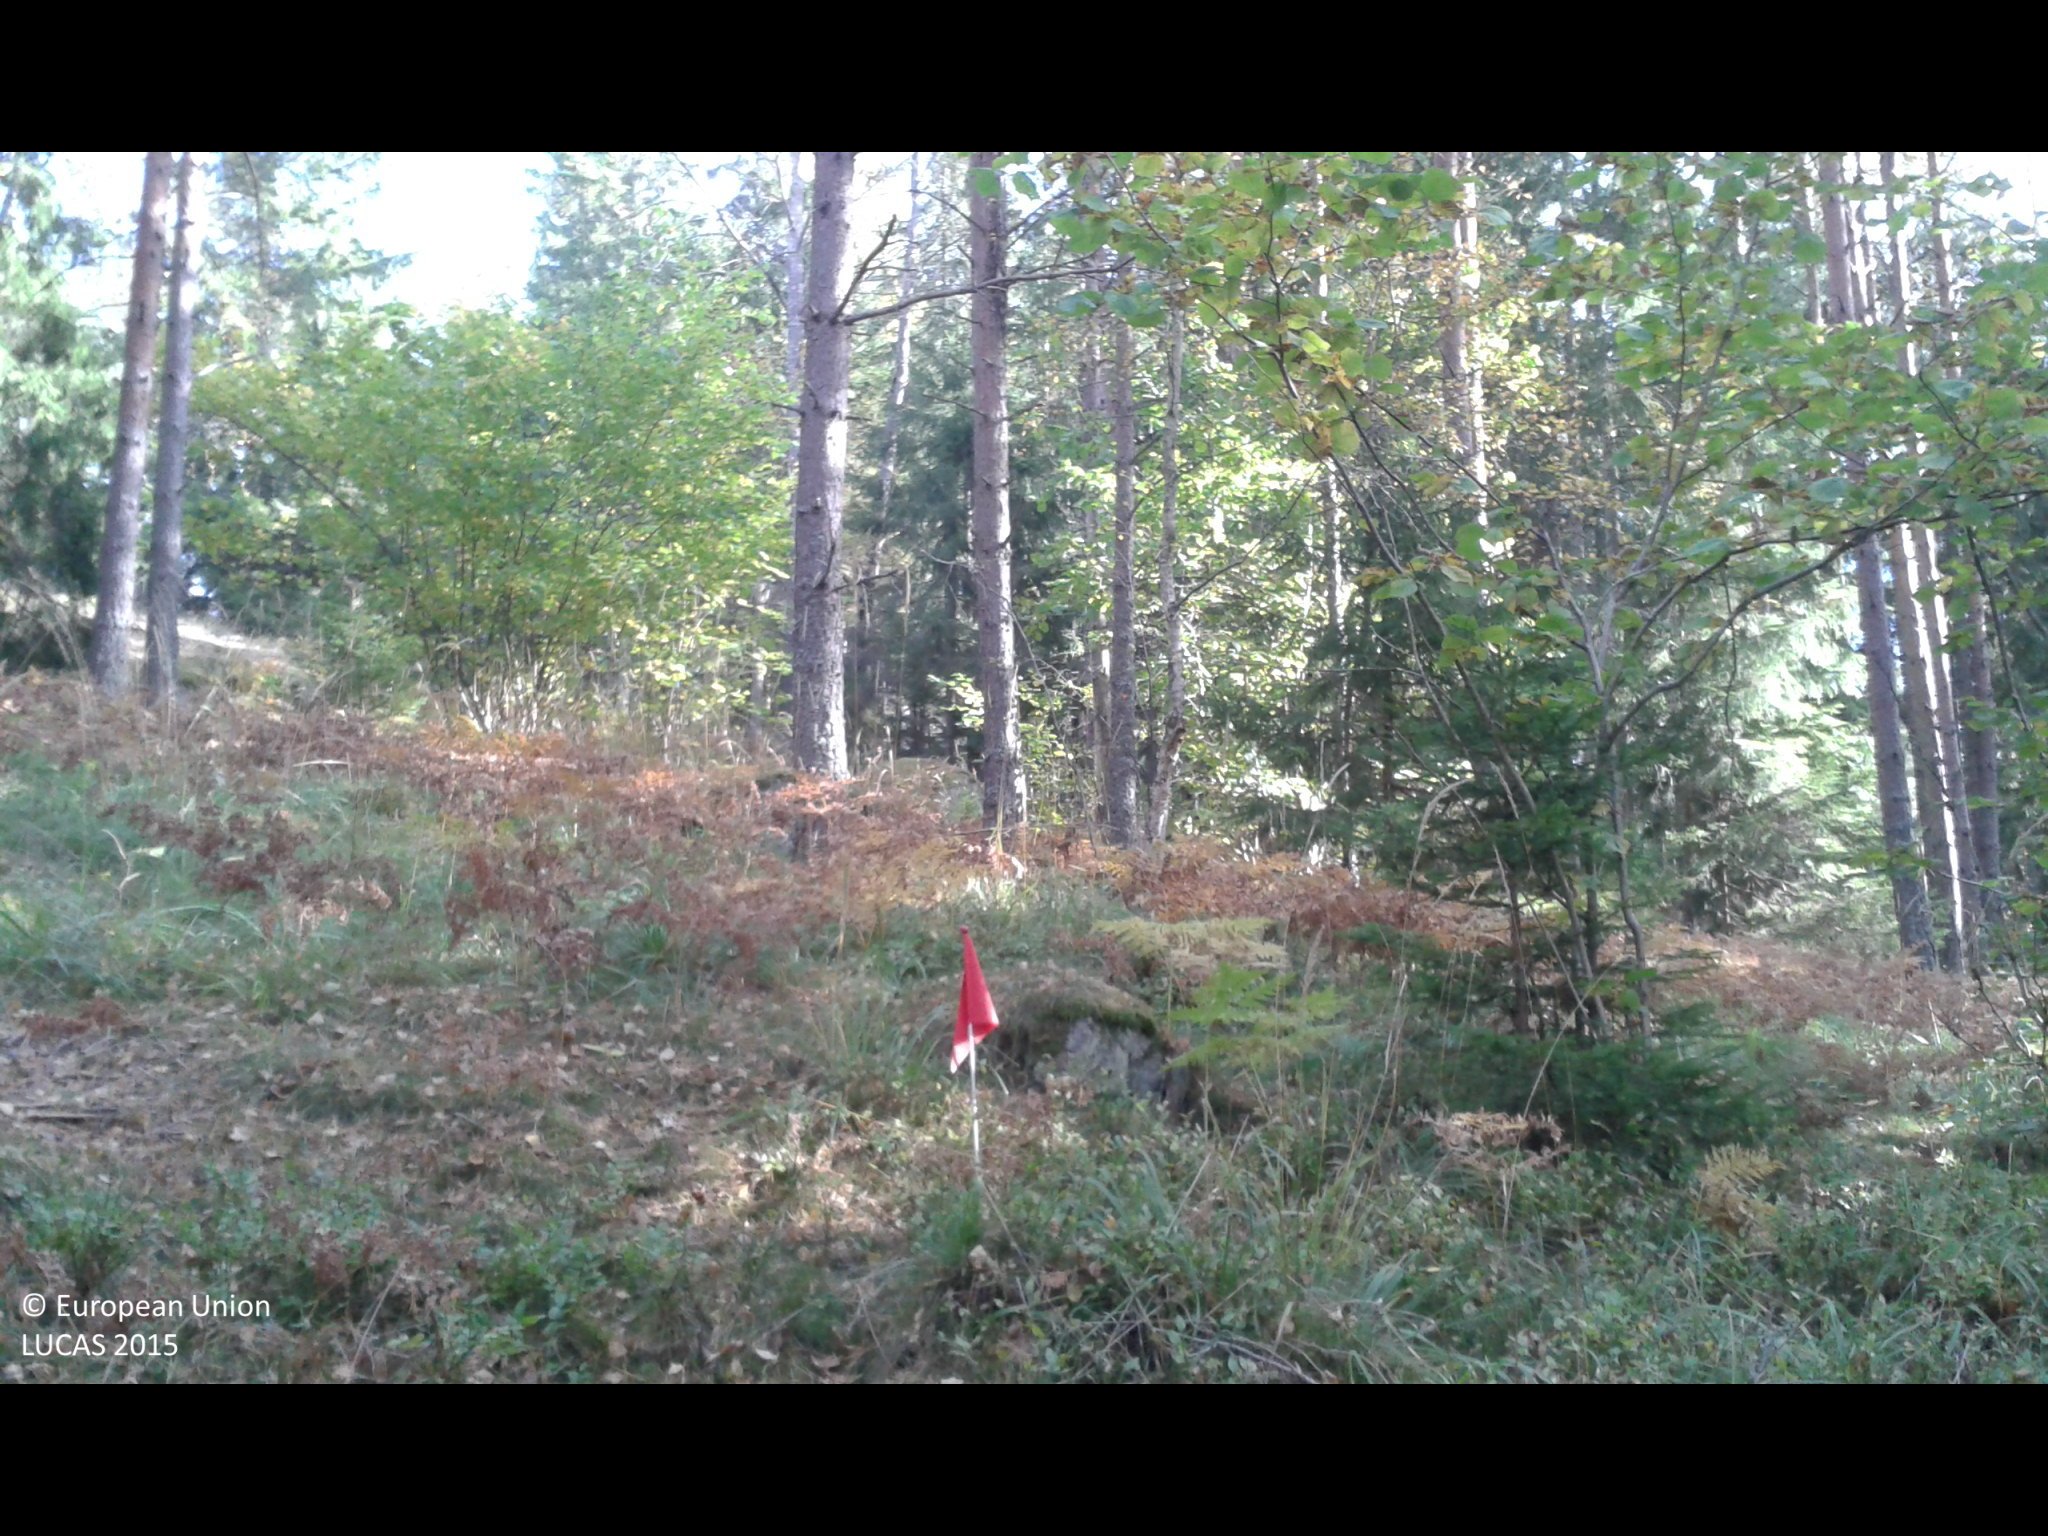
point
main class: Woodland
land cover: Pine dominated coniferous woodland
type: boreal forest
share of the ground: 50 - 75 %
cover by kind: coniferous forest trees 55 %, herbaceous plants 40 %, broadleaved forest trees 5 %
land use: Forestry
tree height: > 5 m
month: October
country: SE
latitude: 58.9223
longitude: 17.3441
